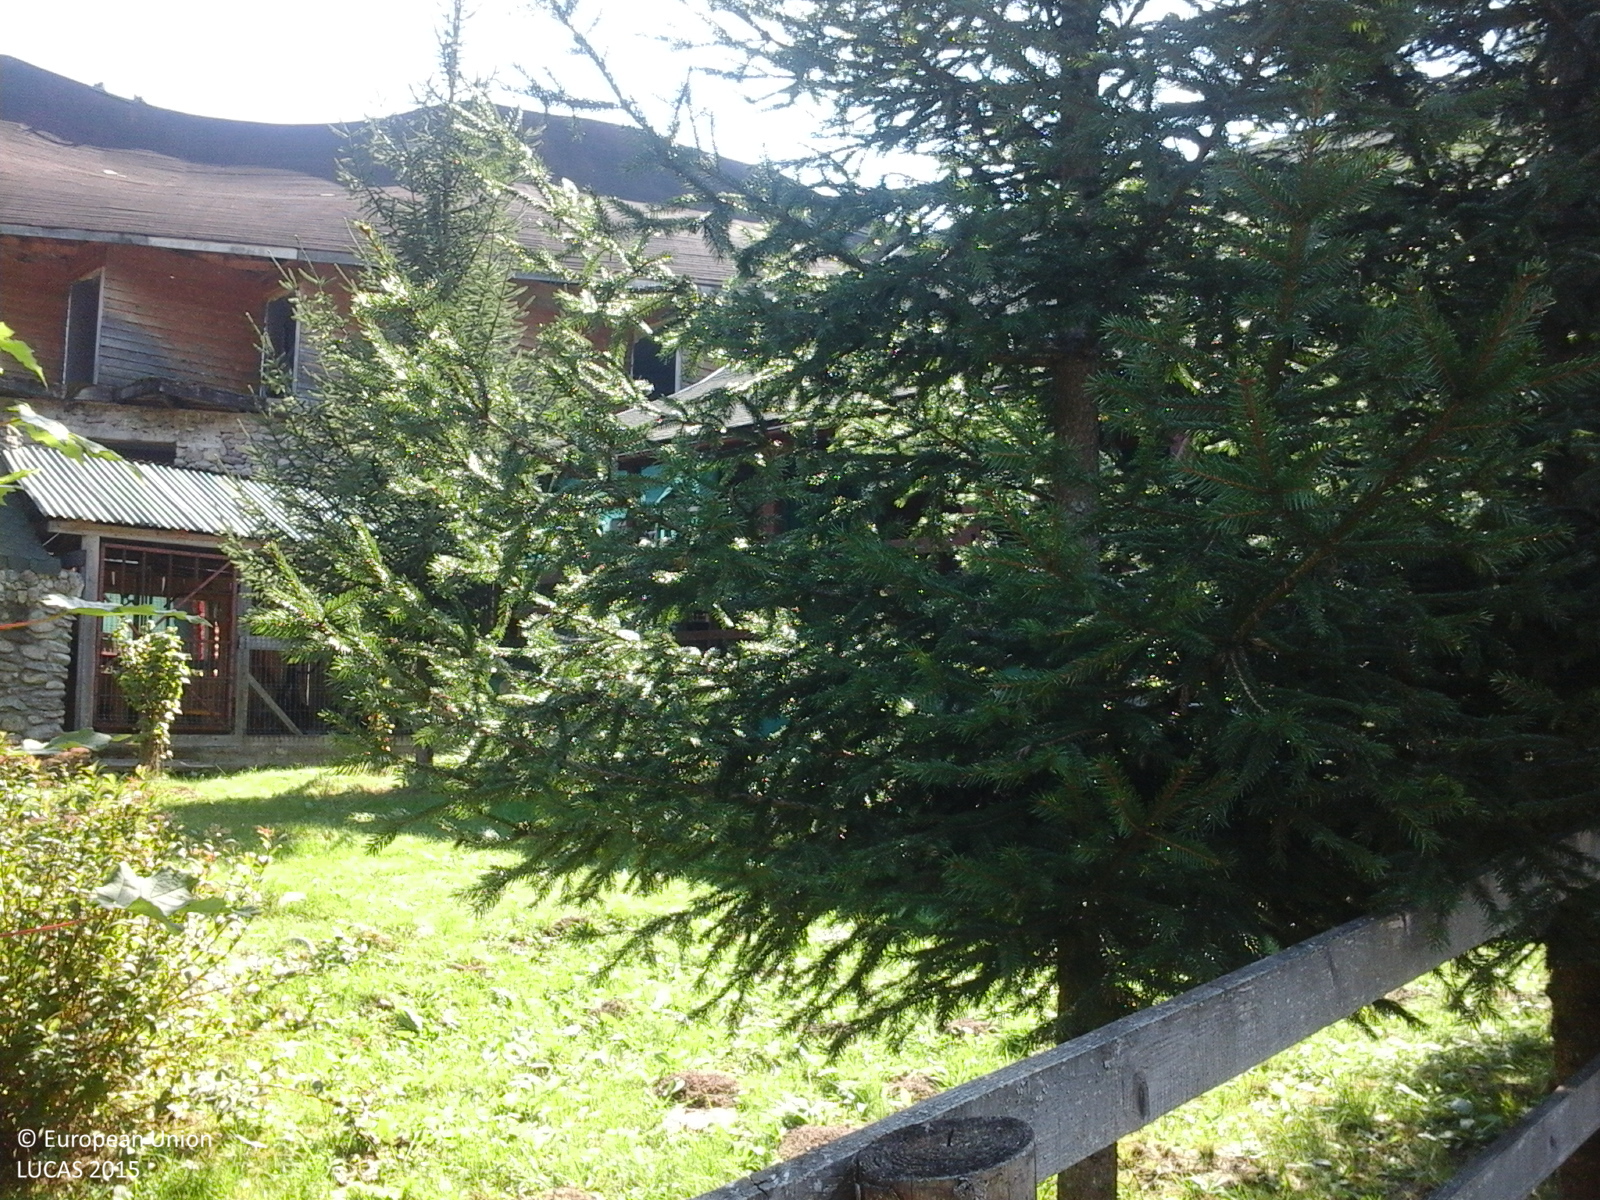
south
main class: Grassland
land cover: Grassland with sparse tree/shrub cover
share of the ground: > 75 %
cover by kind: herbaceous plants 85 %, shrubs 10 %, broadleaved forest trees 5 %
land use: Agriculture (excluding fallow land and kitchen gardens)
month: September
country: RO
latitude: 46.7910
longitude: 22.5648
